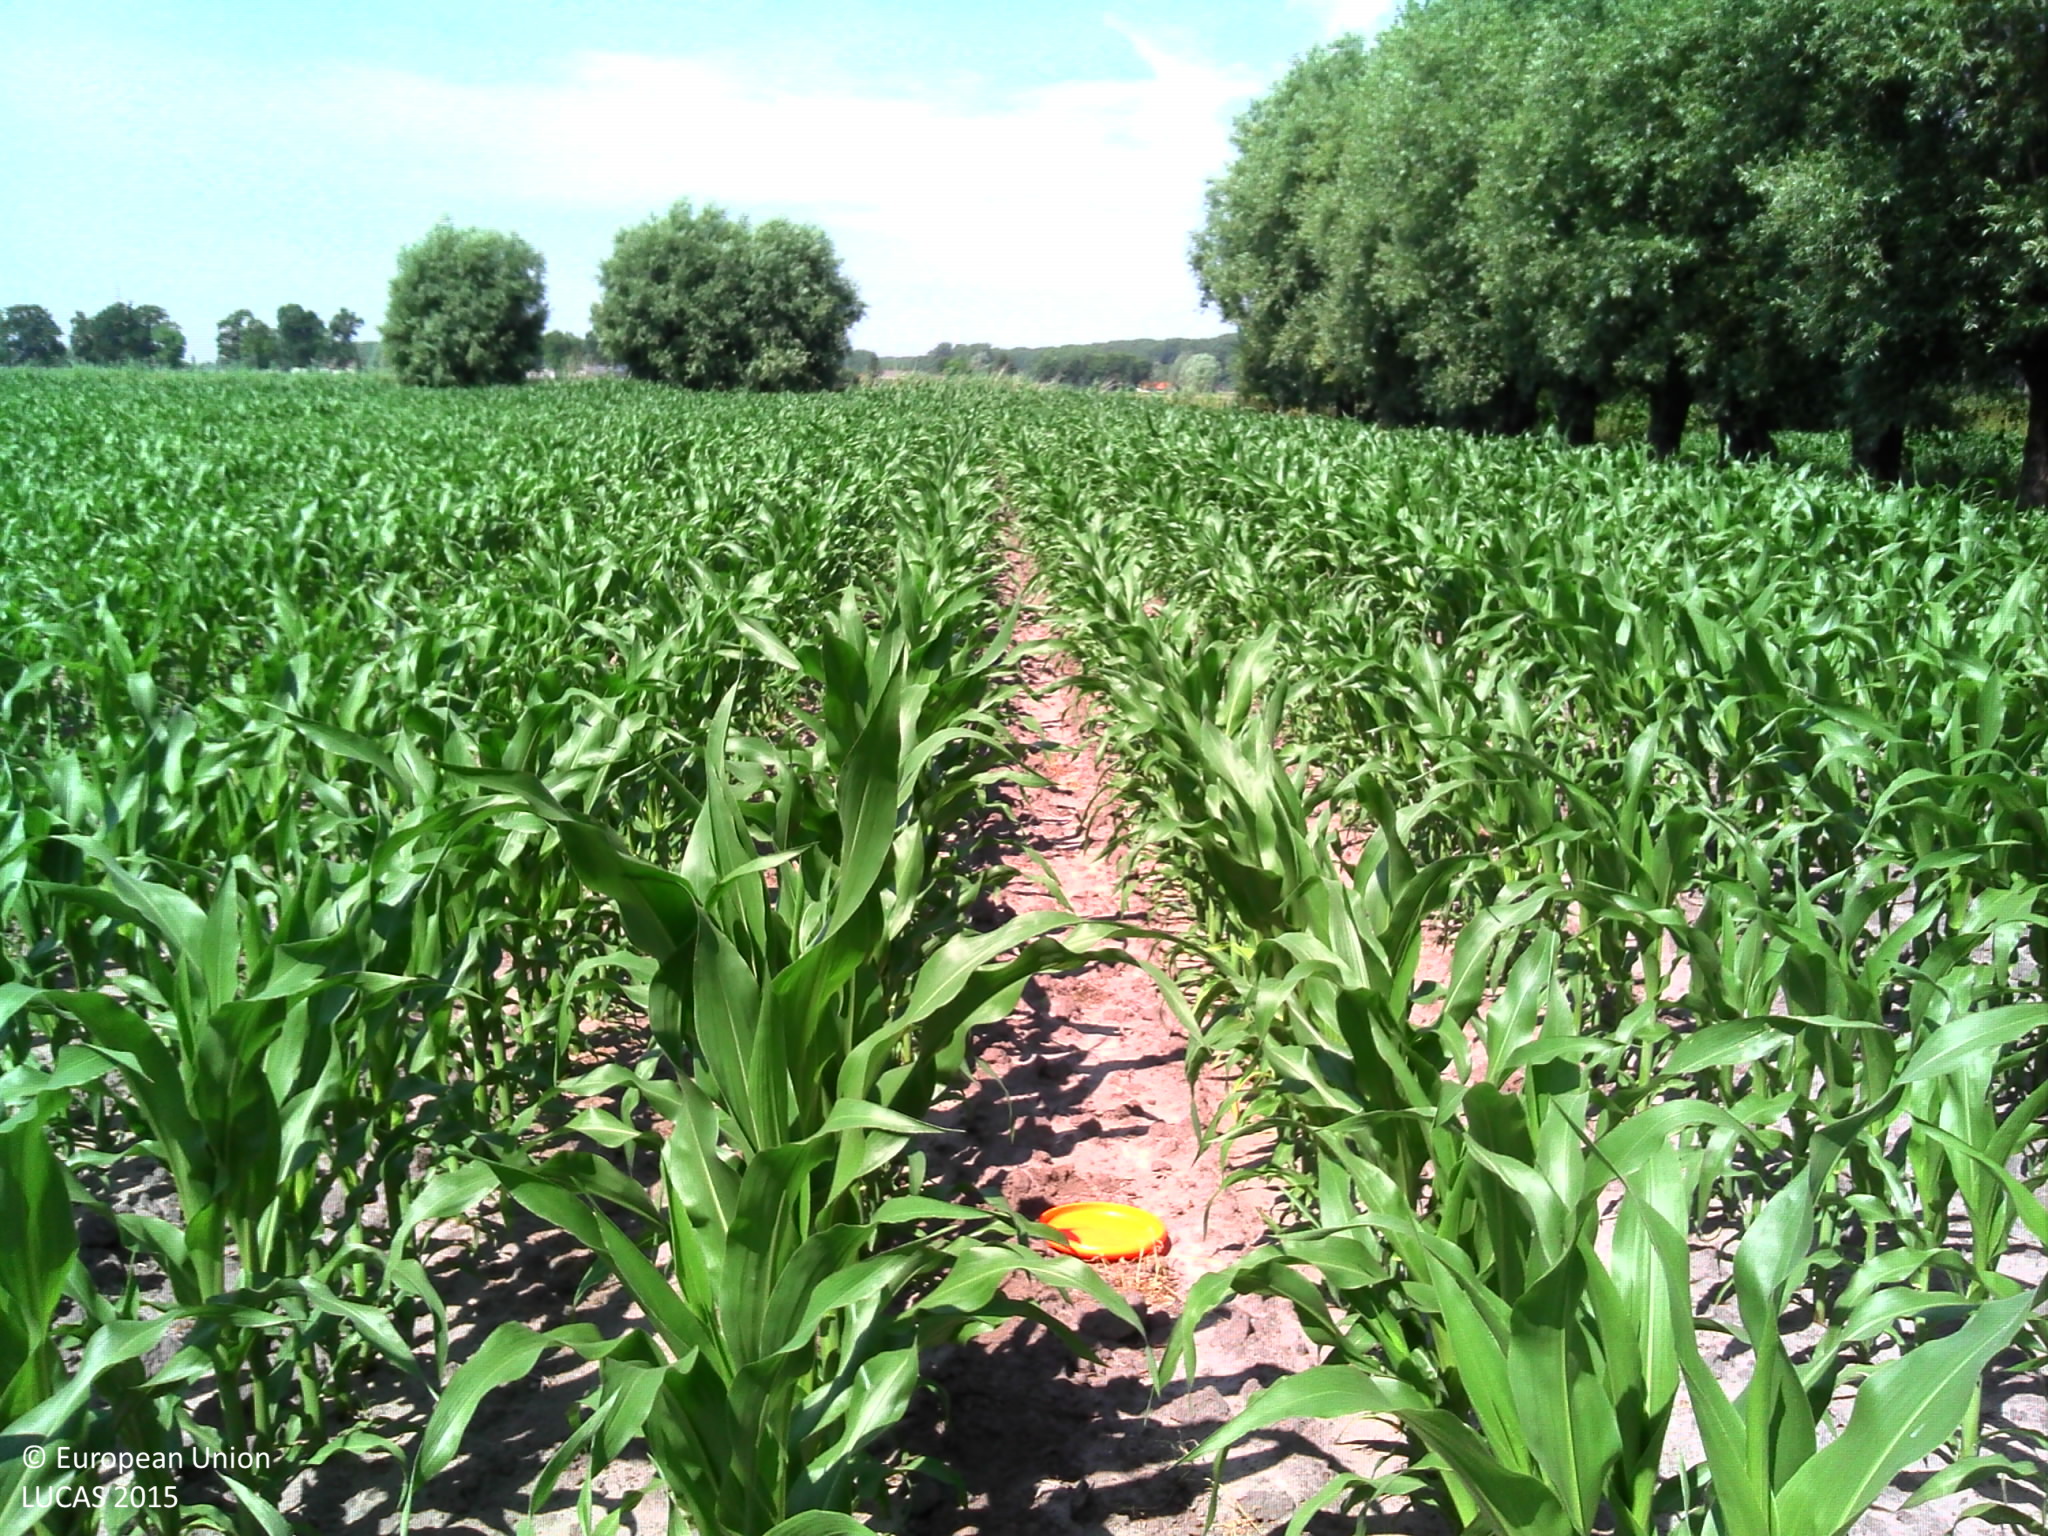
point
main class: Cropland
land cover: Maize
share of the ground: > 75 %
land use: Agriculture (excluding fallow land and kitchen gardens)
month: July
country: BE
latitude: 51.2388
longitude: 3.4173
